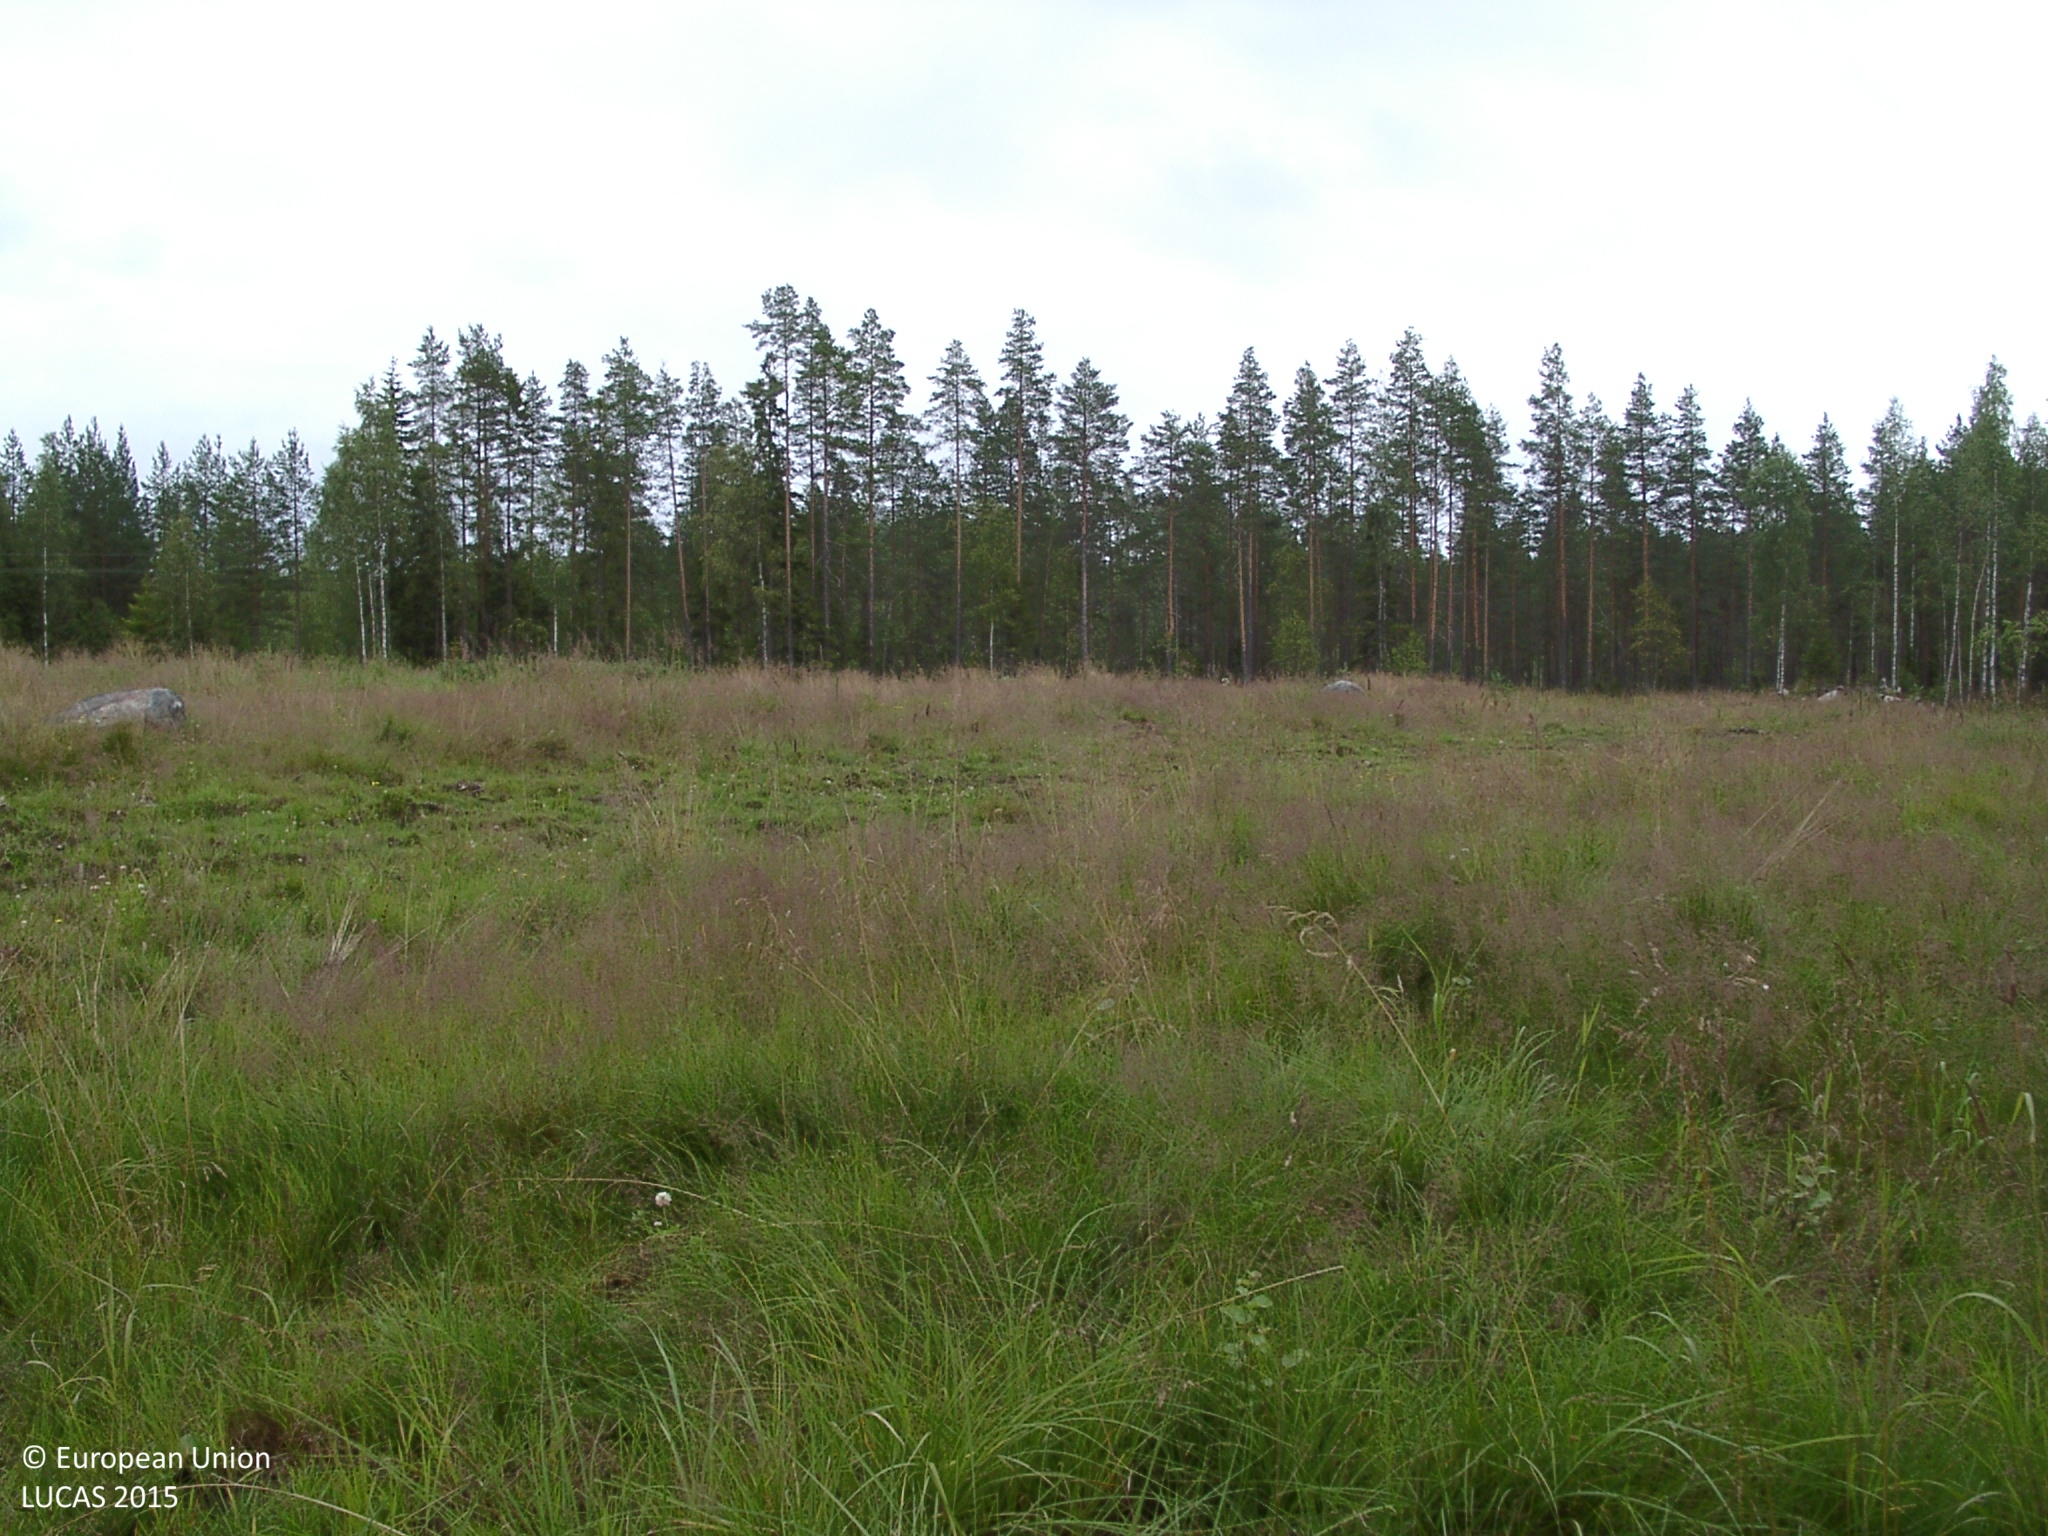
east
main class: Grassland
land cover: Grassland without tree/shrub cover
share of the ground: > 75 %
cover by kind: herbaceous plants 90 %, unconsolidated bare surface 10 %
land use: Agriculture (excluding fallow land and kitchen gardens)
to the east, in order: Grassland without tree/shrub cover; Ditches and canals; Other mixed woodland; Tracks; Electric lines; Shruby margins; Groves; Ditches and canals; Pine dominated mixed woodland; Ditches and canals; Managed hedges; Paved roads, cycling and walking lanes; Ditches and canals; Pine dominated mixed woodland
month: August
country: FI
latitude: 62.8479
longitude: 24.6437
